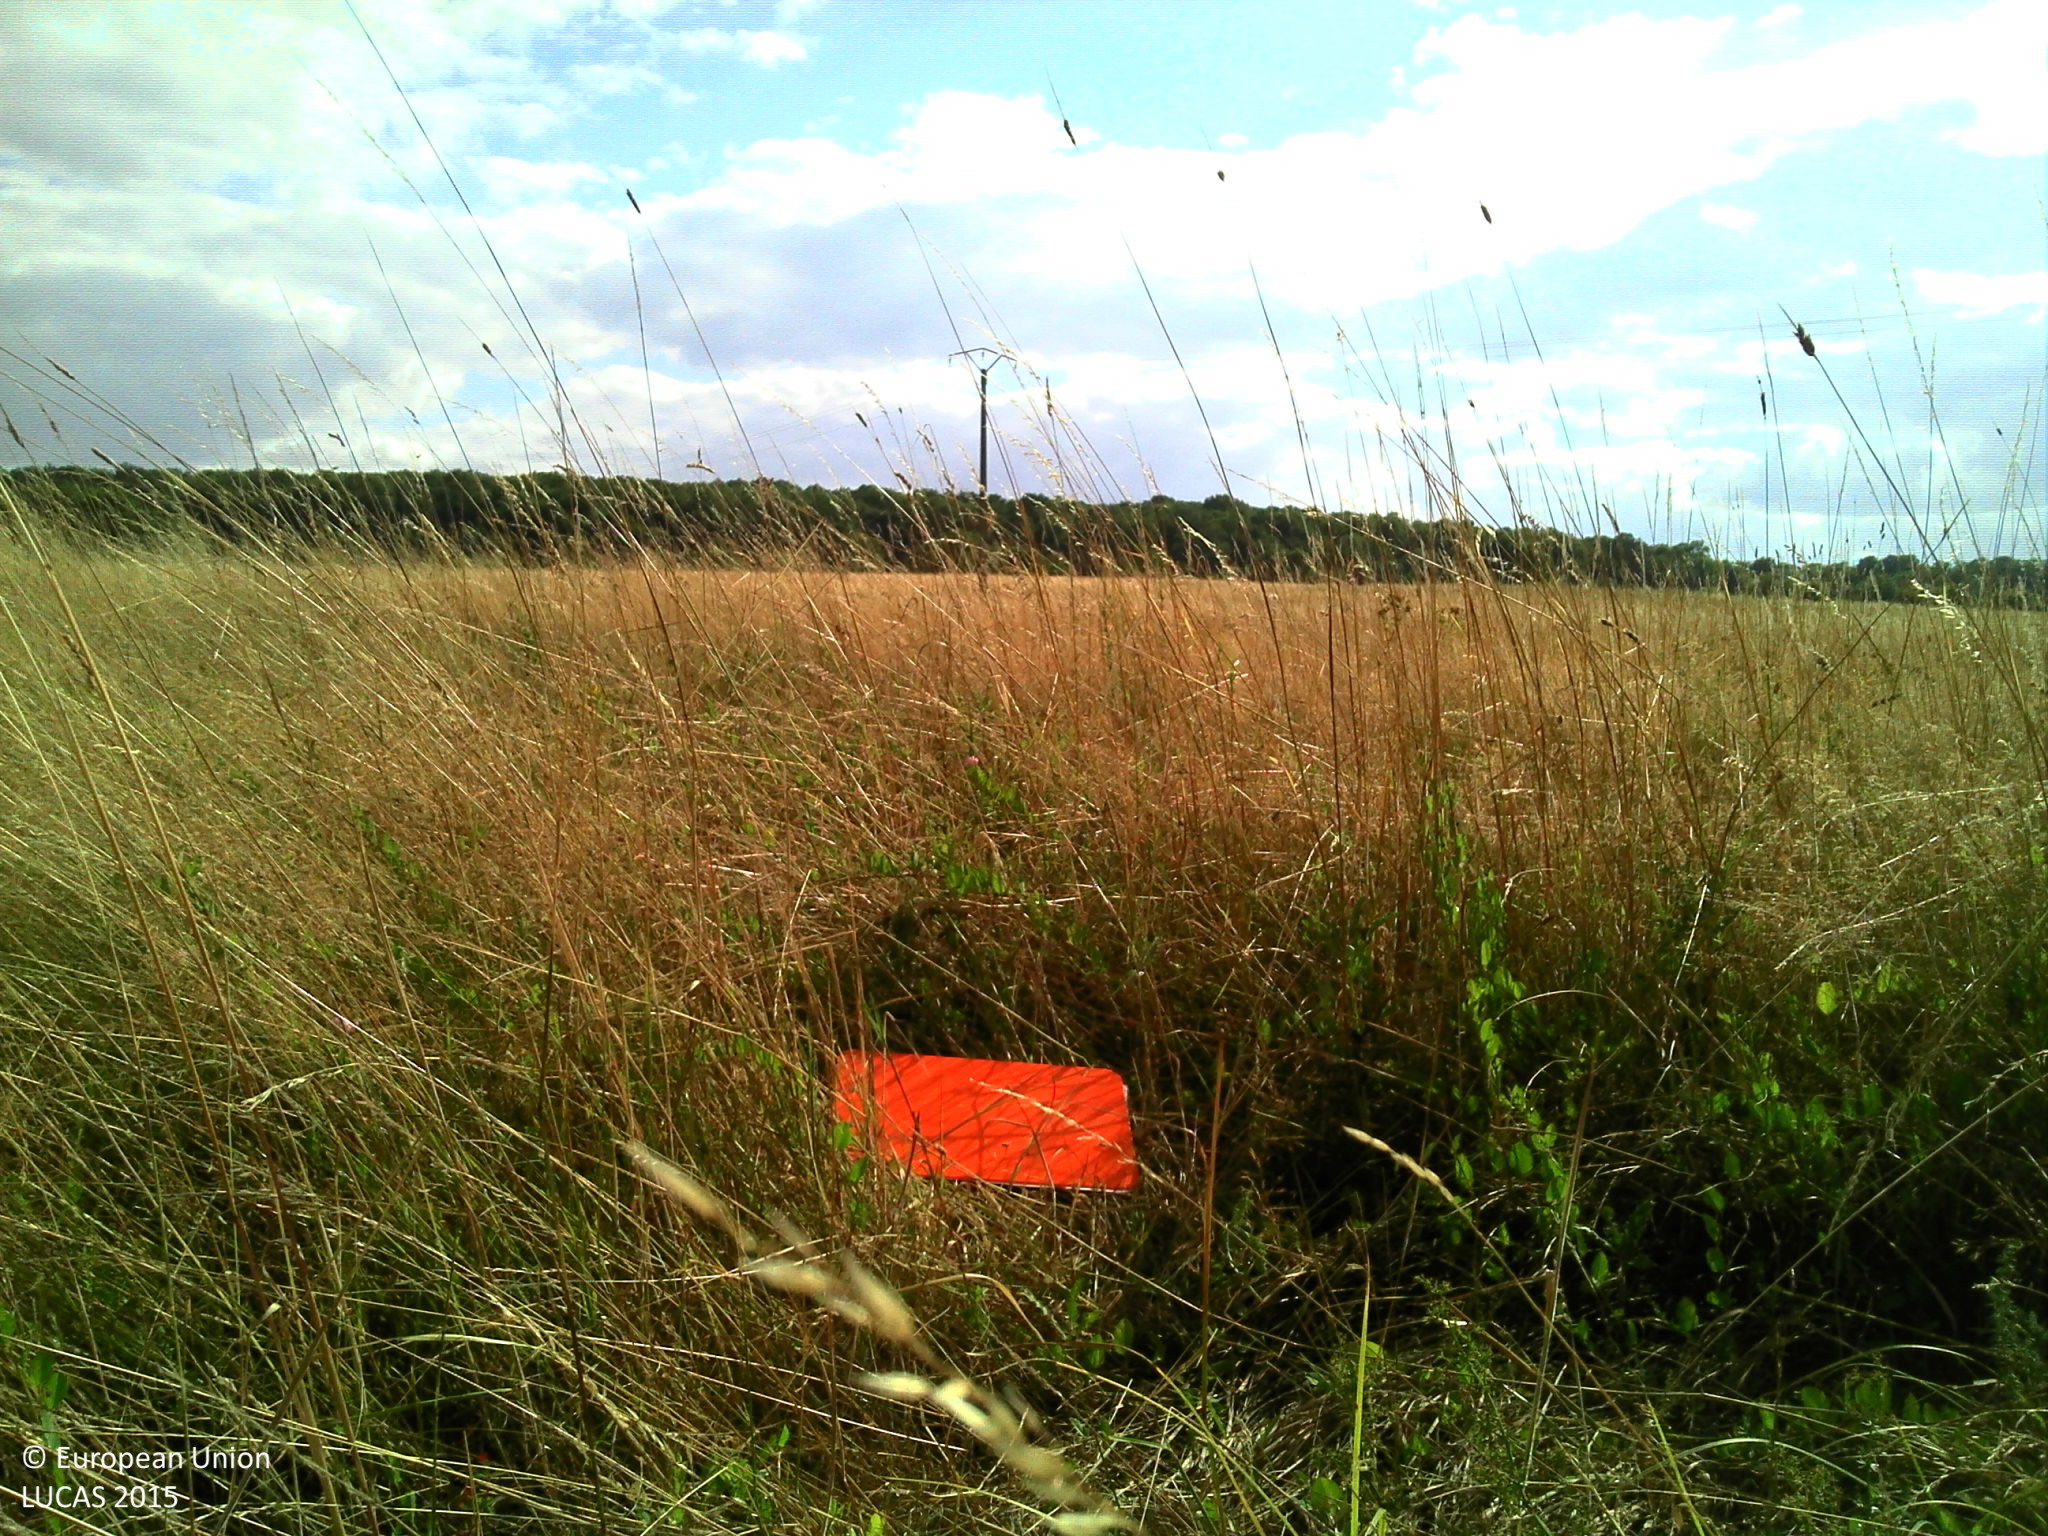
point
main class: Grassland
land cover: Grassland without tree/shrub cover
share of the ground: > 75 %
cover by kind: herbaceous plants 90 %, lichens and mosses 5 %, unconsolidated bare surface 5 %
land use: Agriculture (excluding fallow land and kitchen gardens)
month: July
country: FR
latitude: 48.9487
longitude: 3.7541
